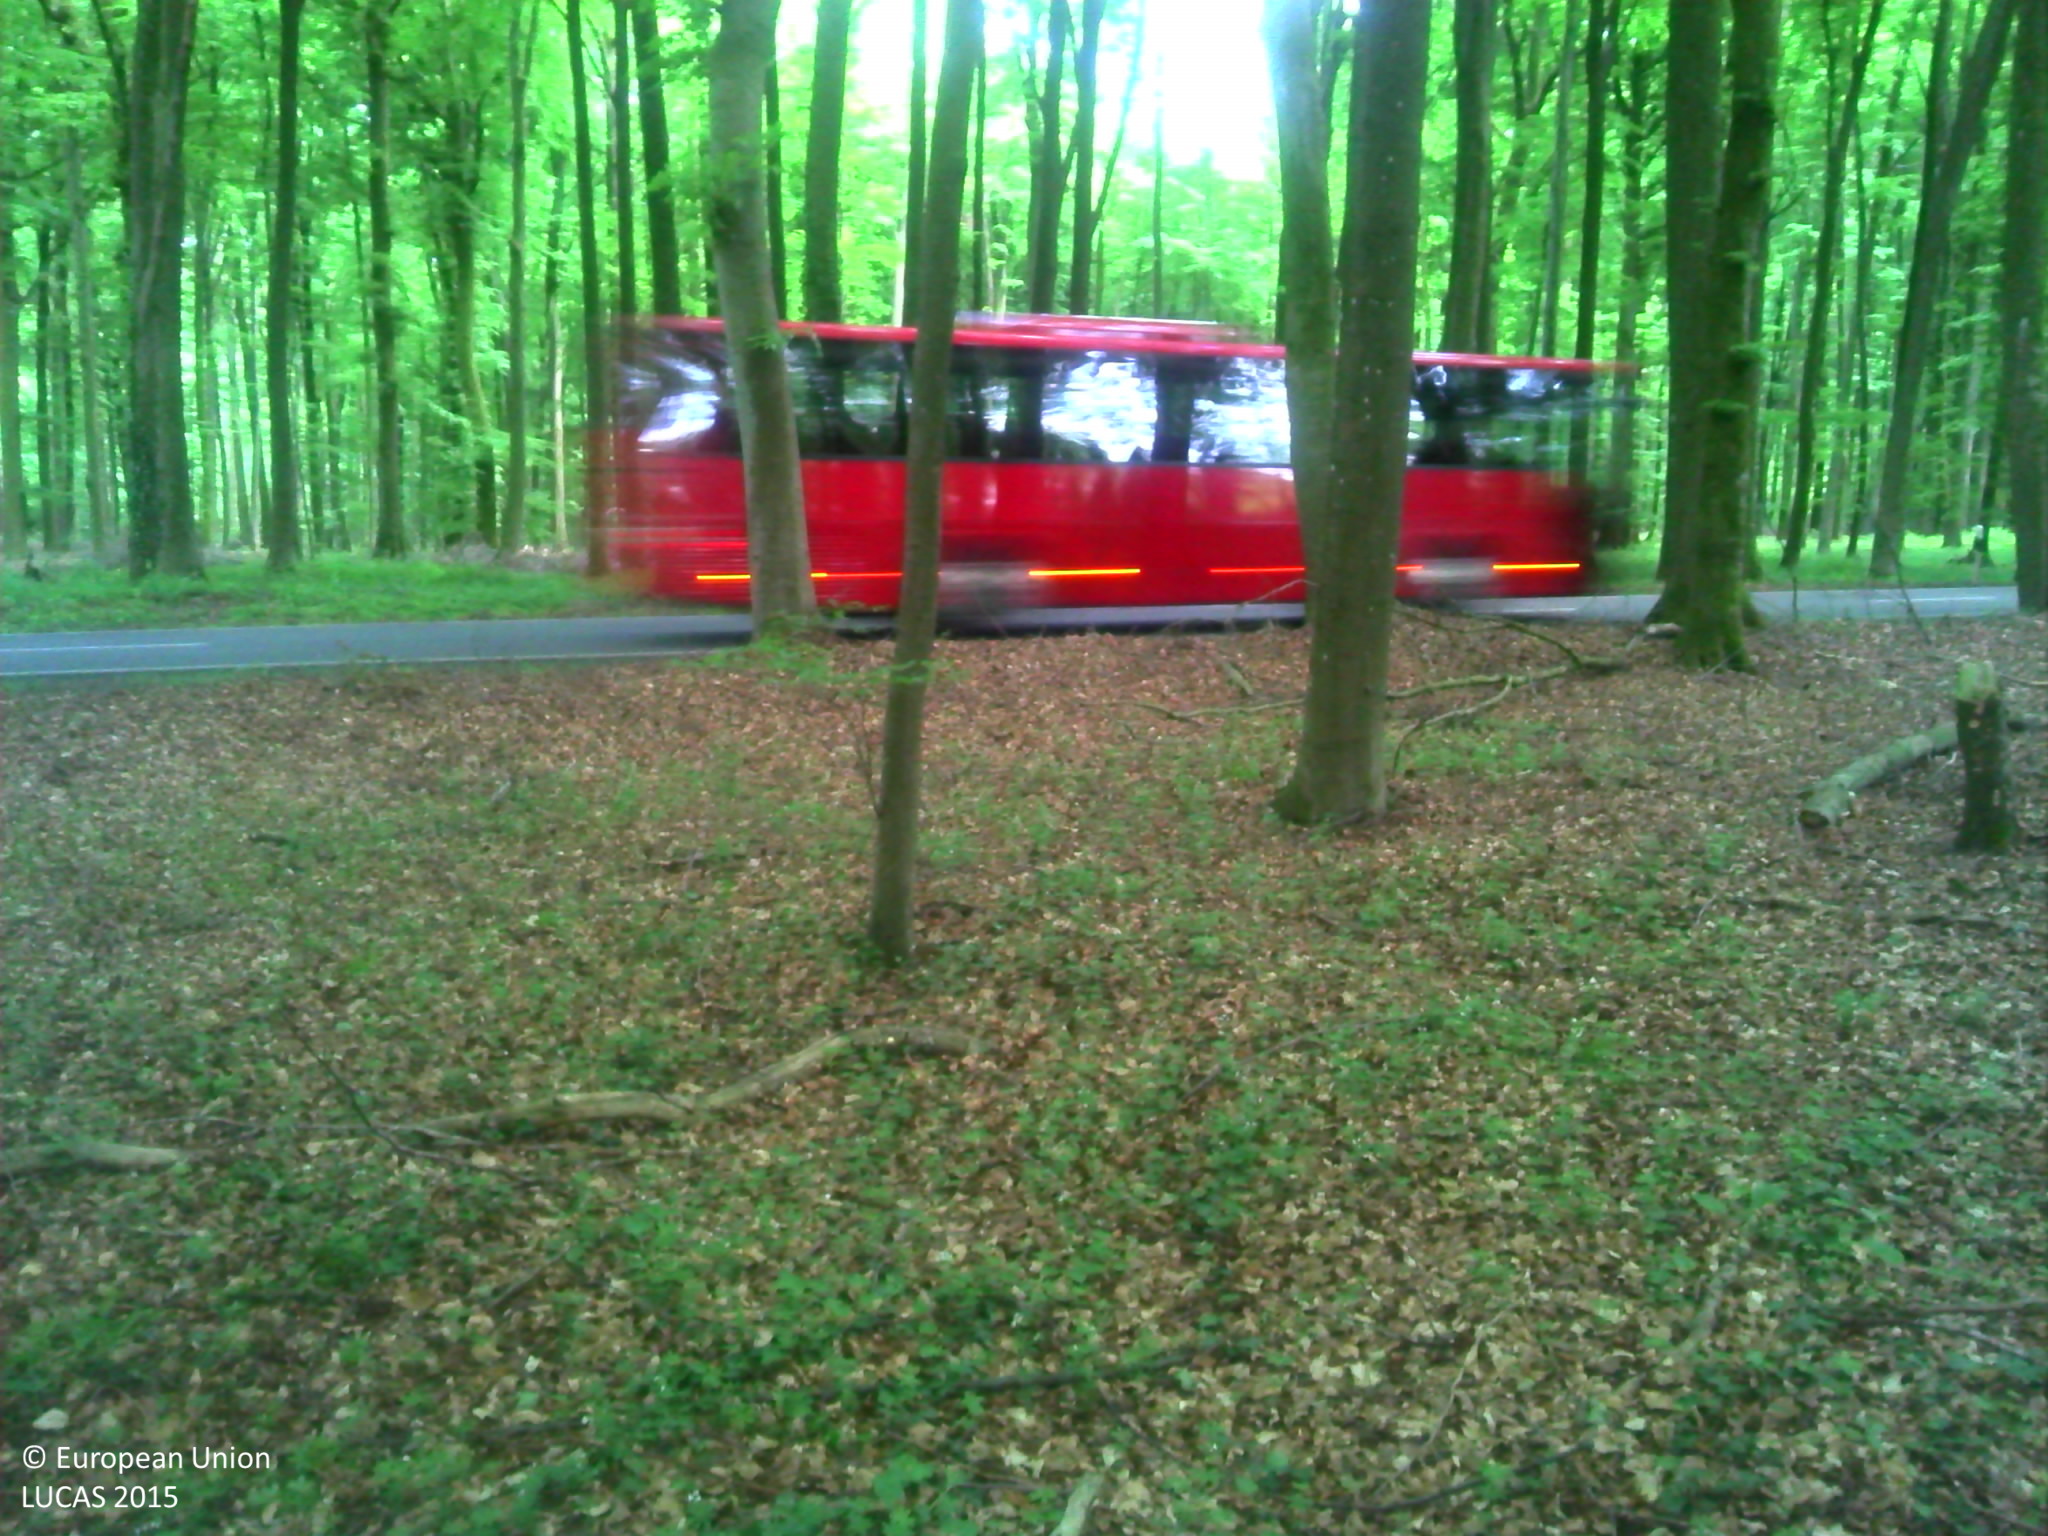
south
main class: Woodland
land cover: Broadleaved woodland
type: beech forest
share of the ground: > 75 %
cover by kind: broadleaved forest trees 90 %, herbaceous plants 10 %
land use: Forestry
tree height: > 5 m
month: May
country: LU
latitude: 49.7167
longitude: 5.9631
